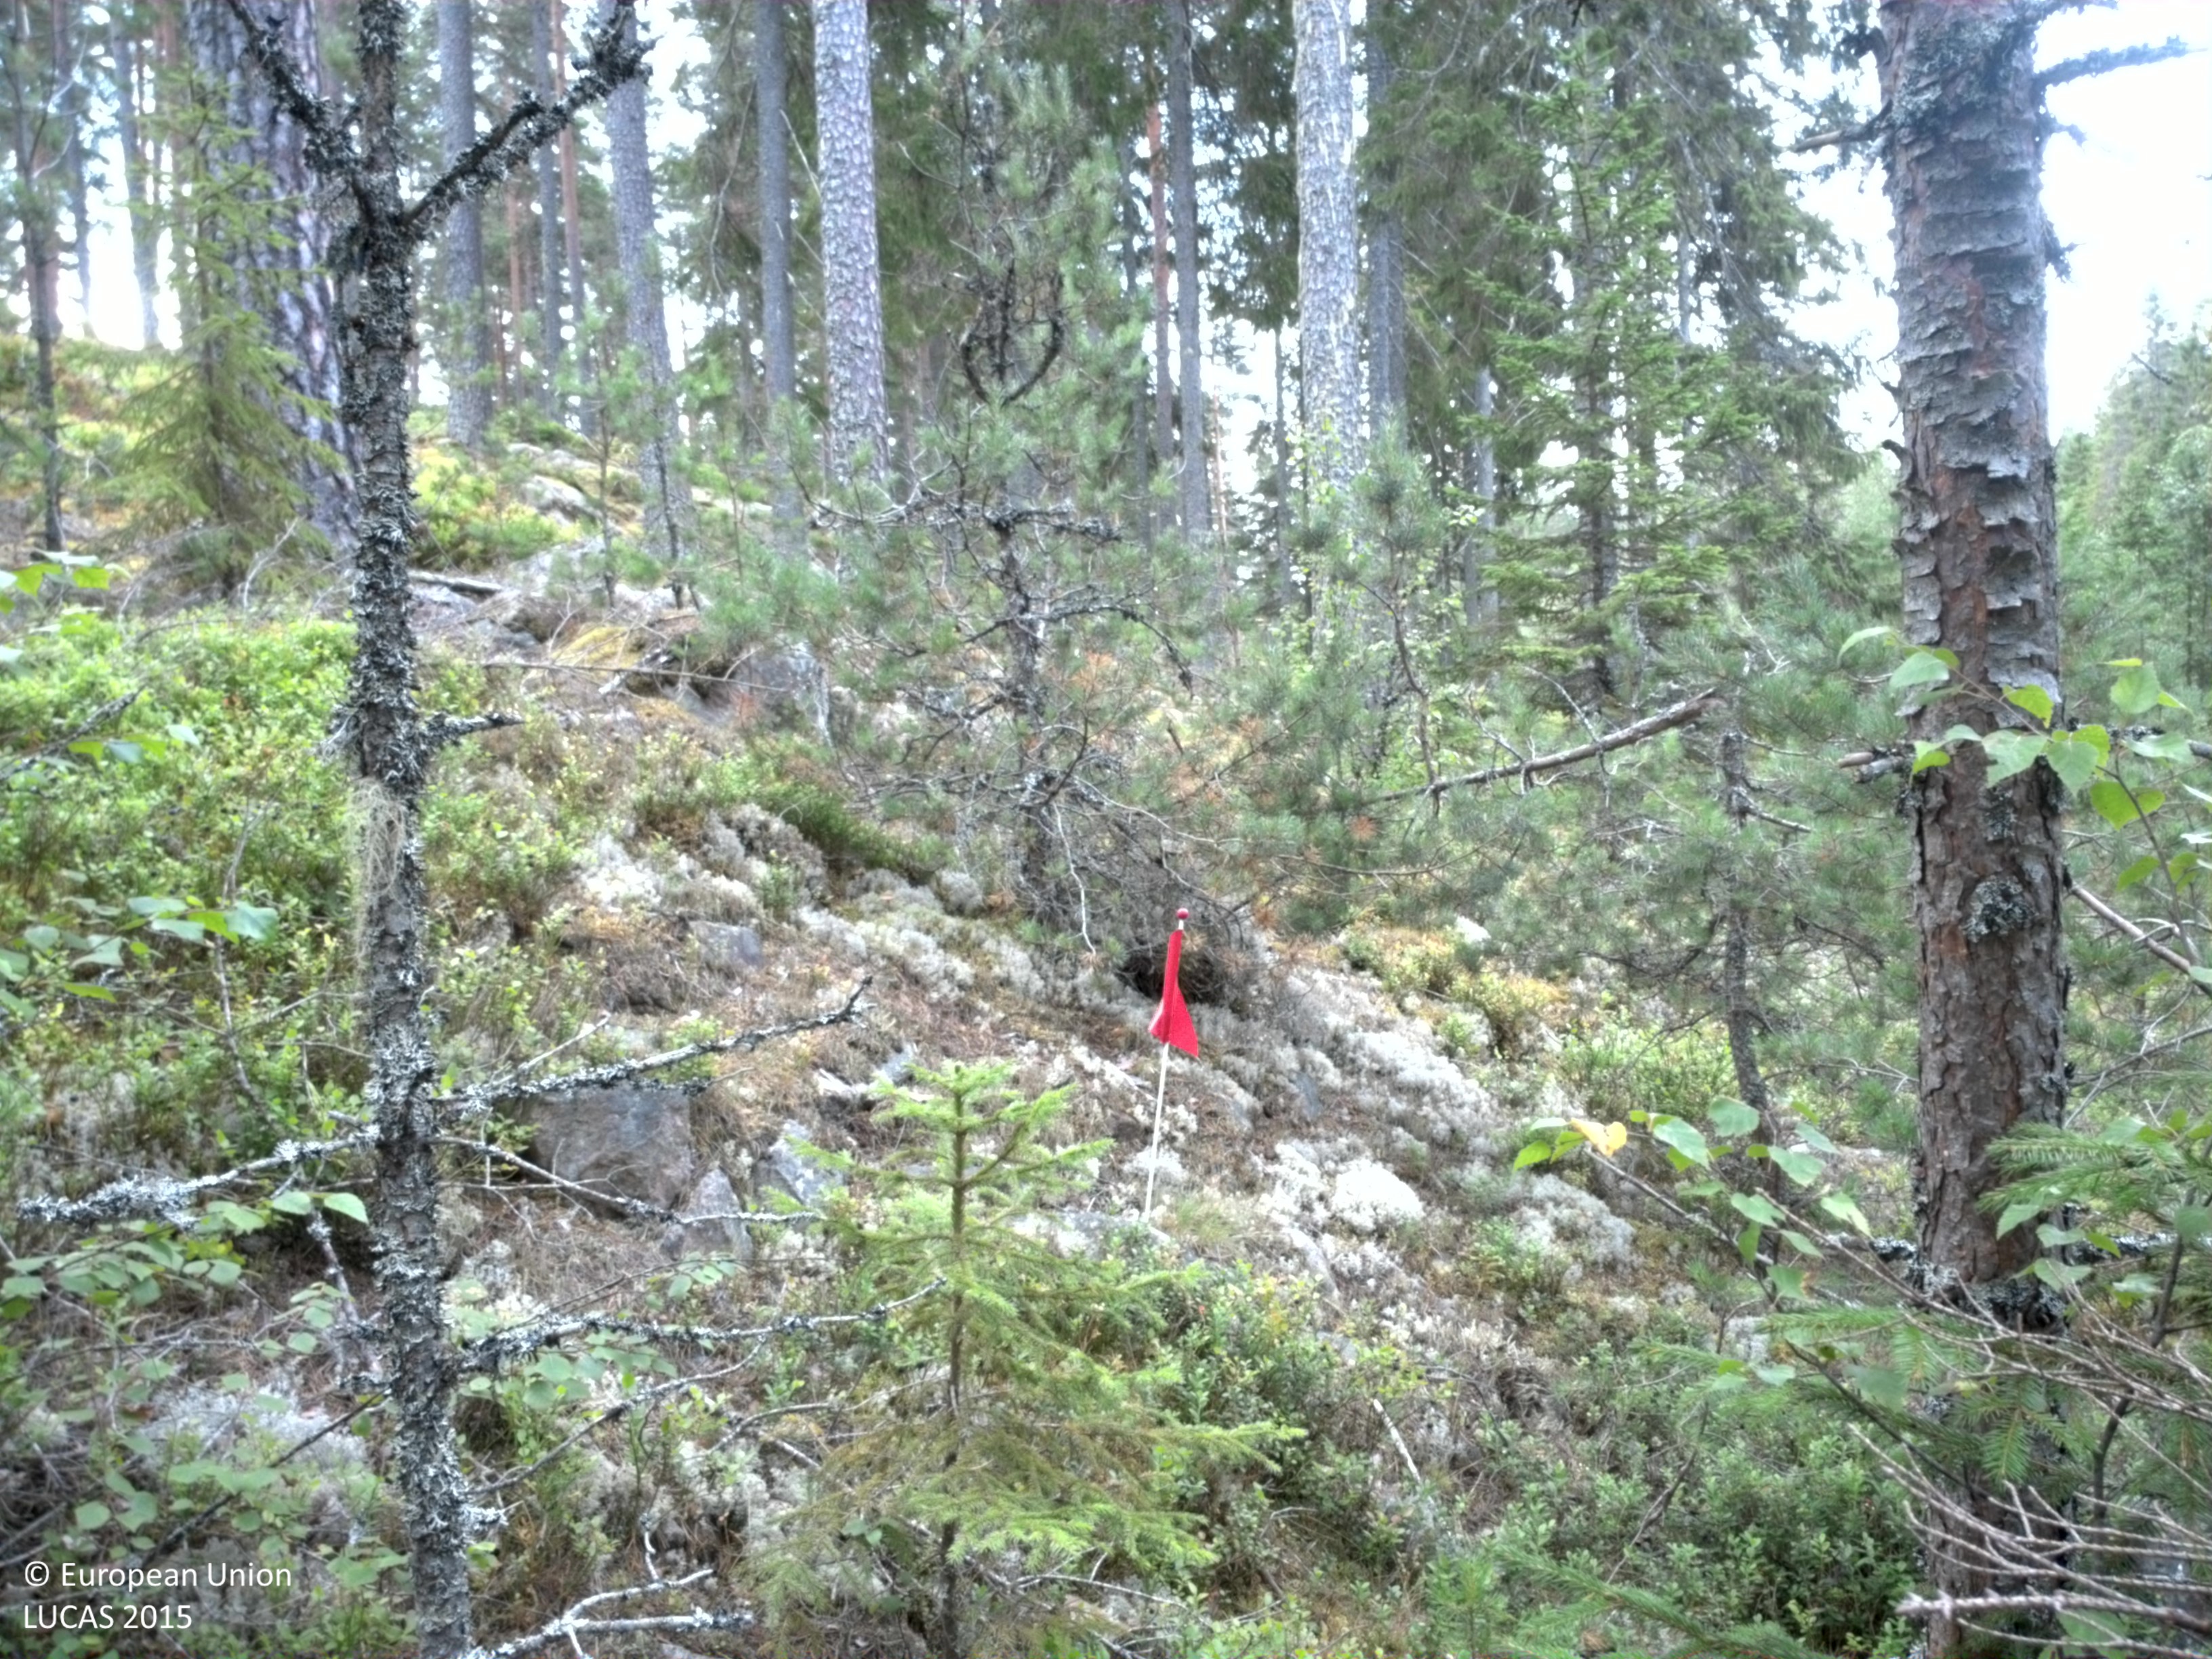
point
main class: Woodland
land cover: Pine dominated coniferous woodland
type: boreal forest
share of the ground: 50 - 75 %
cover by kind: coniferous forest trees 55 %, shrubs 25 %, lichens and mosses 20 %
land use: Forestry
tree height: > 5 m
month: August
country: SE
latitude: 60.0140
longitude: 13.3812
